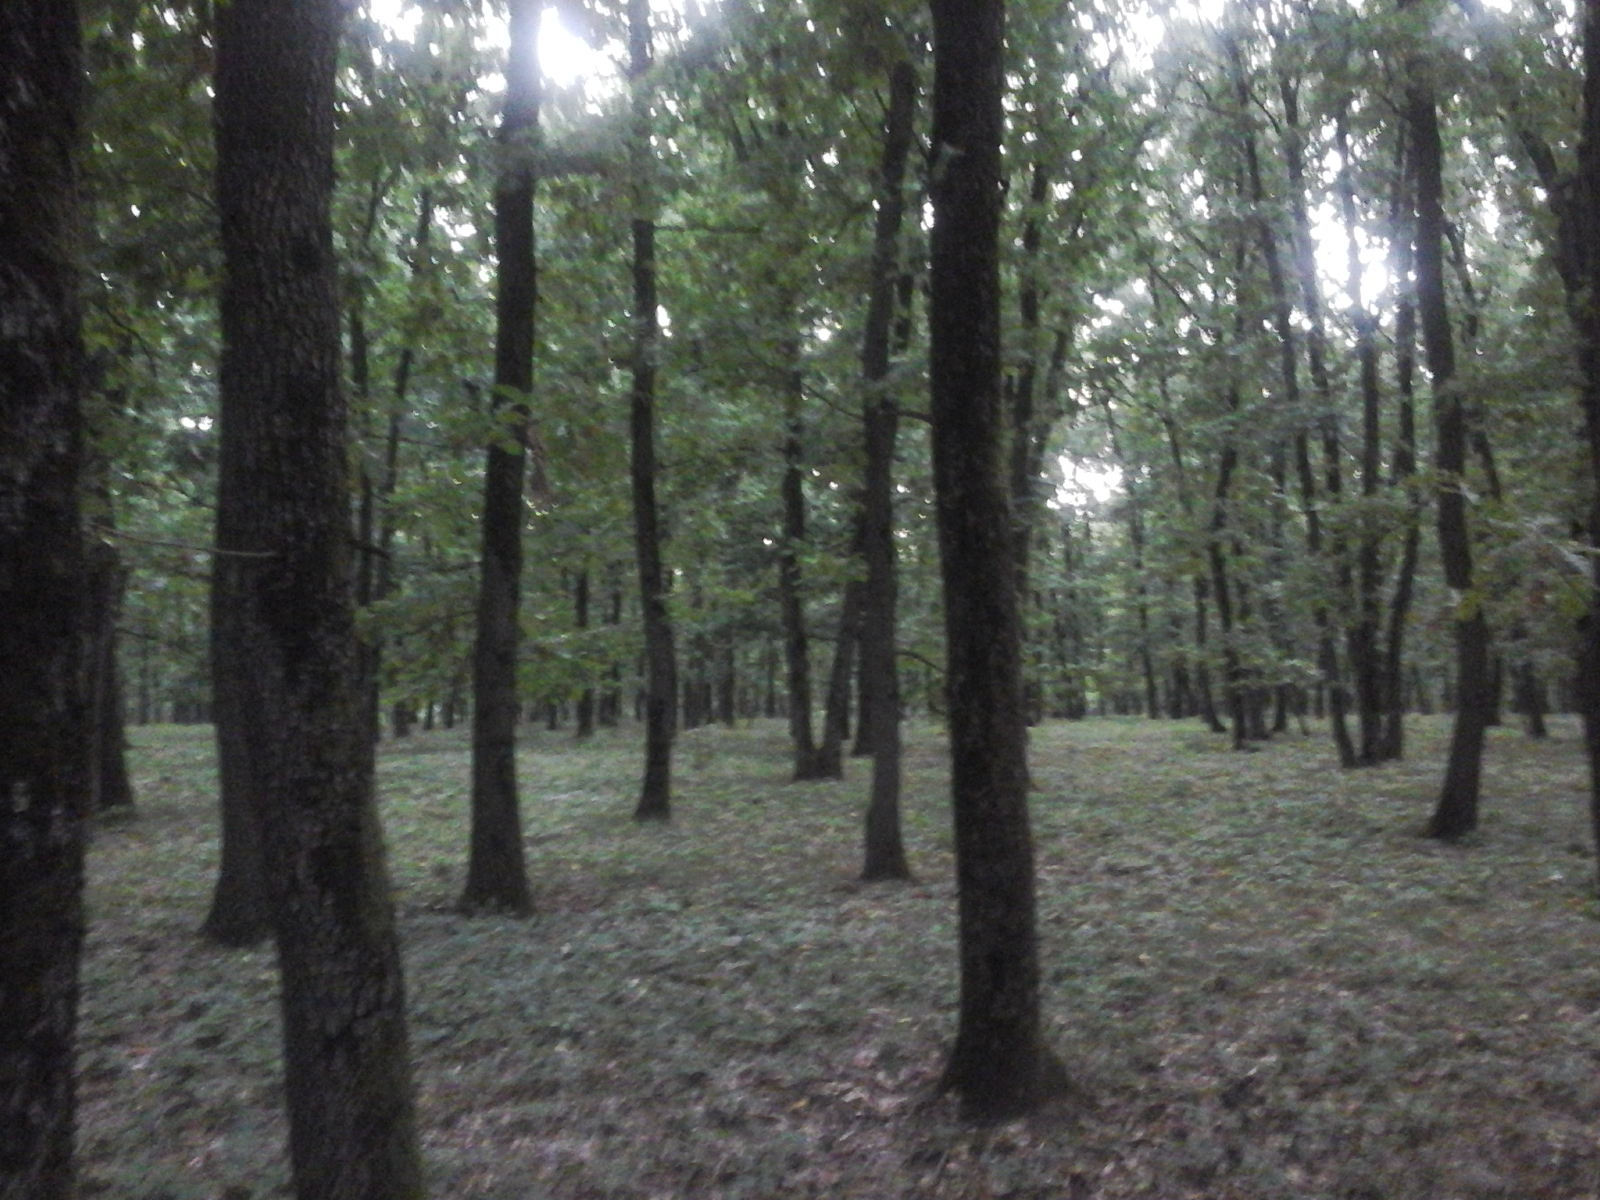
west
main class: Woodland
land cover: Broadleaved woodland
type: acidophilous oak and oak-birch forest
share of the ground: > 75 %
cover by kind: broadleaved forest trees 100 %
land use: Forestry
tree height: > 5 m
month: August
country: RO
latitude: 44.3536
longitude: 23.2588
